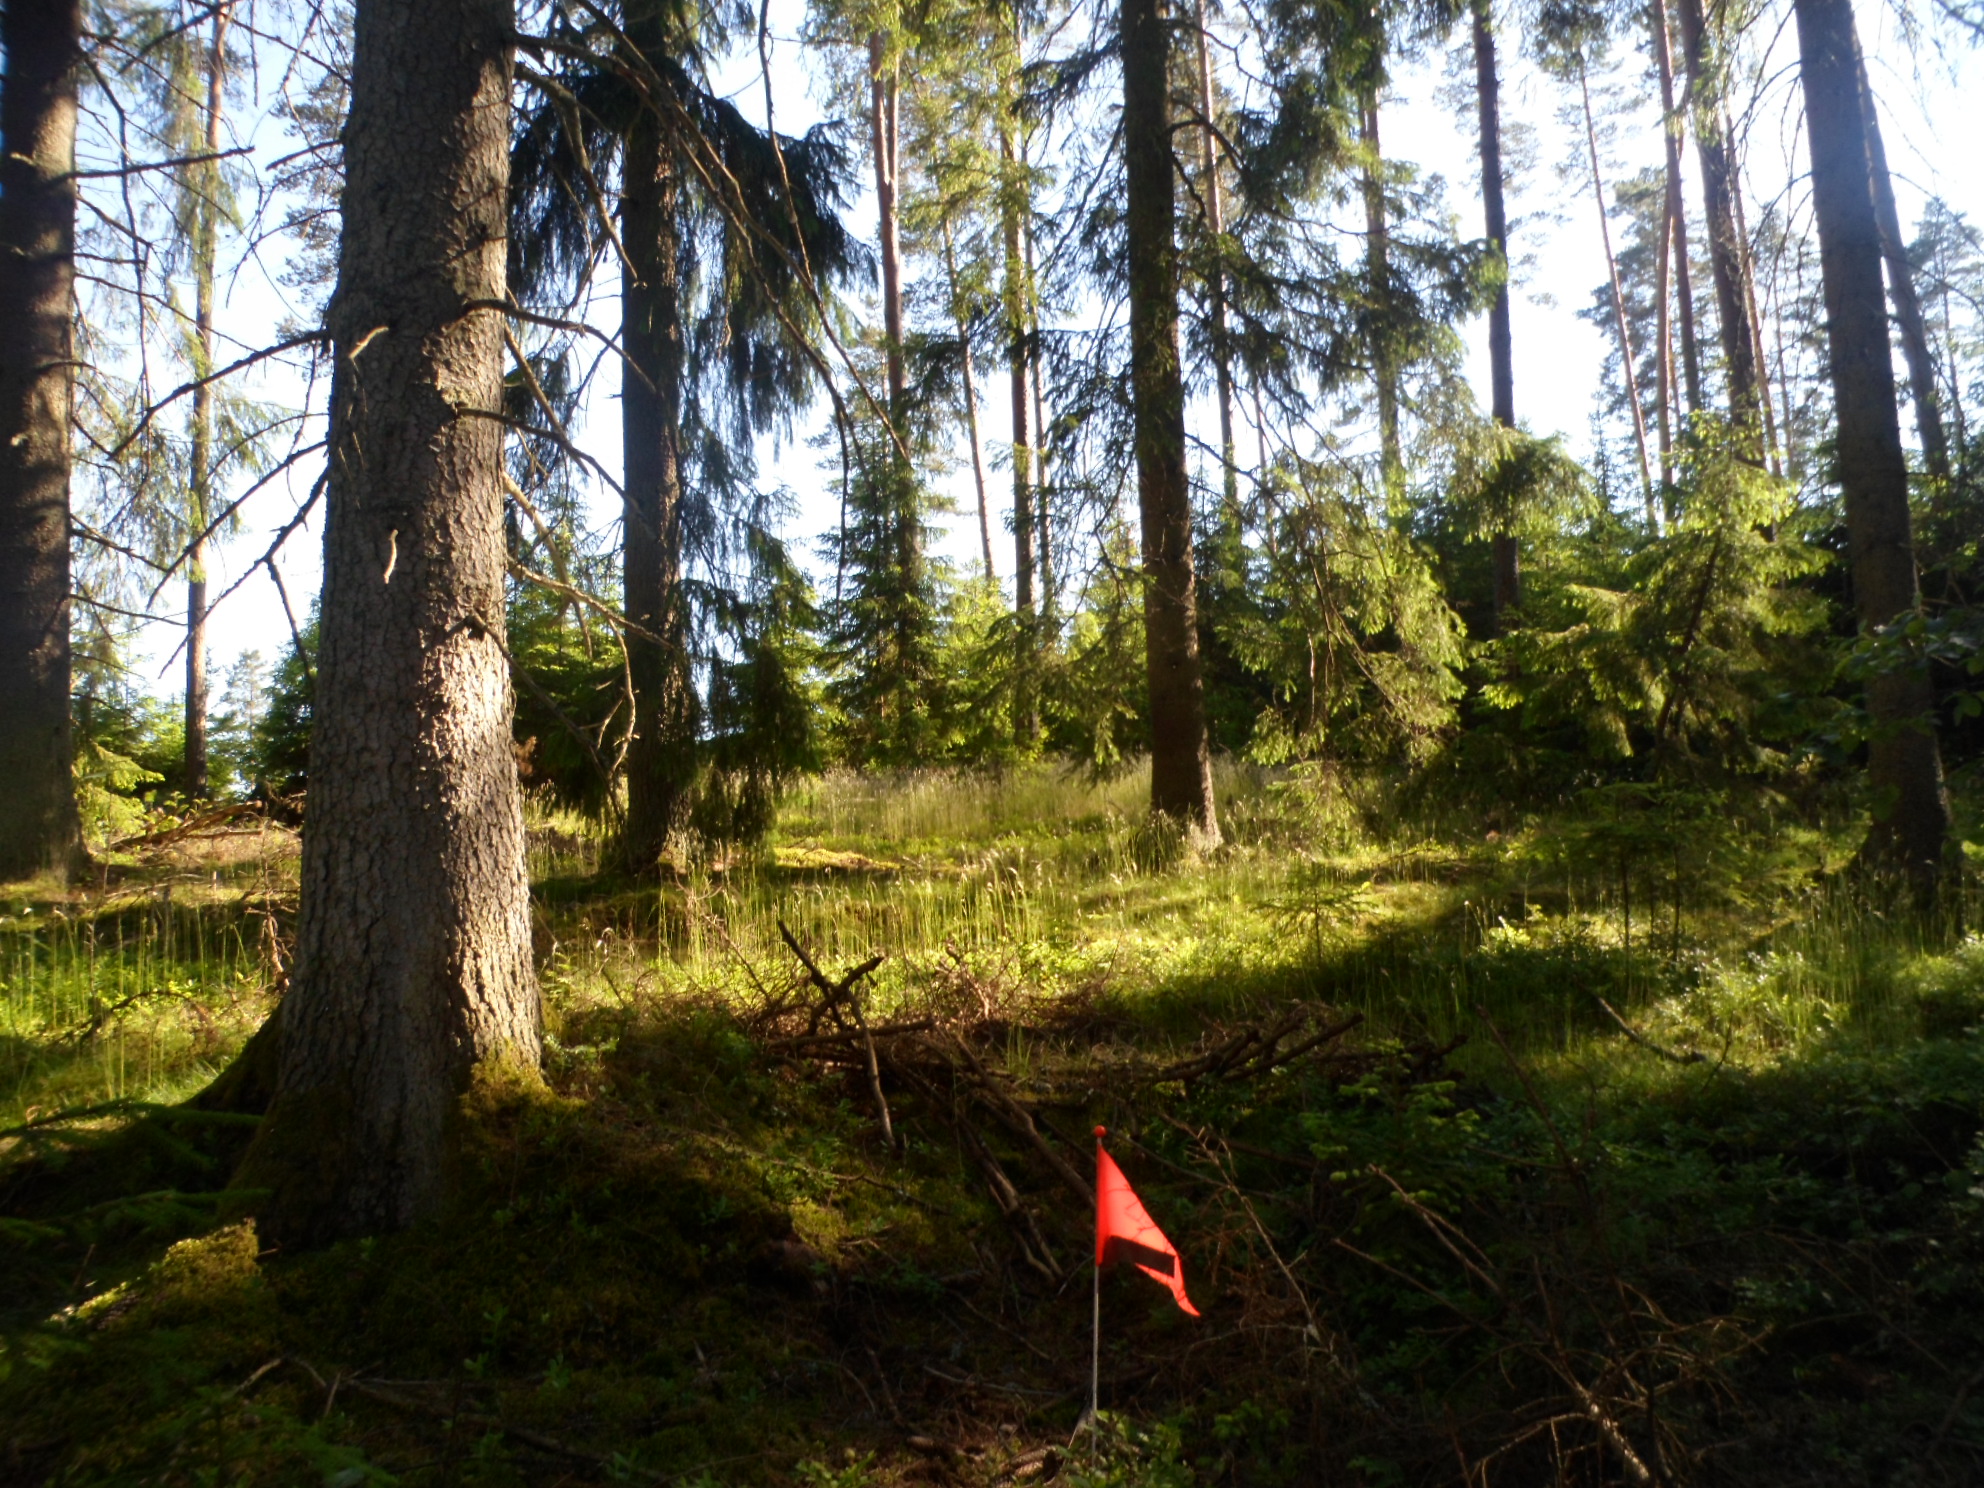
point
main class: Woodland
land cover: Spruce dominated coniferous woodland
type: boreal forest
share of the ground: 50 - 75 %
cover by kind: coniferous forest trees 55 %, shrubs 20 %, broadleaved forest trees 10 %, lichens and mosses 10 %, herbaceous plants 5 %
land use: Forestry
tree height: > 5 m
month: July
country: SE
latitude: 57.4331
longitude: 14.7431
